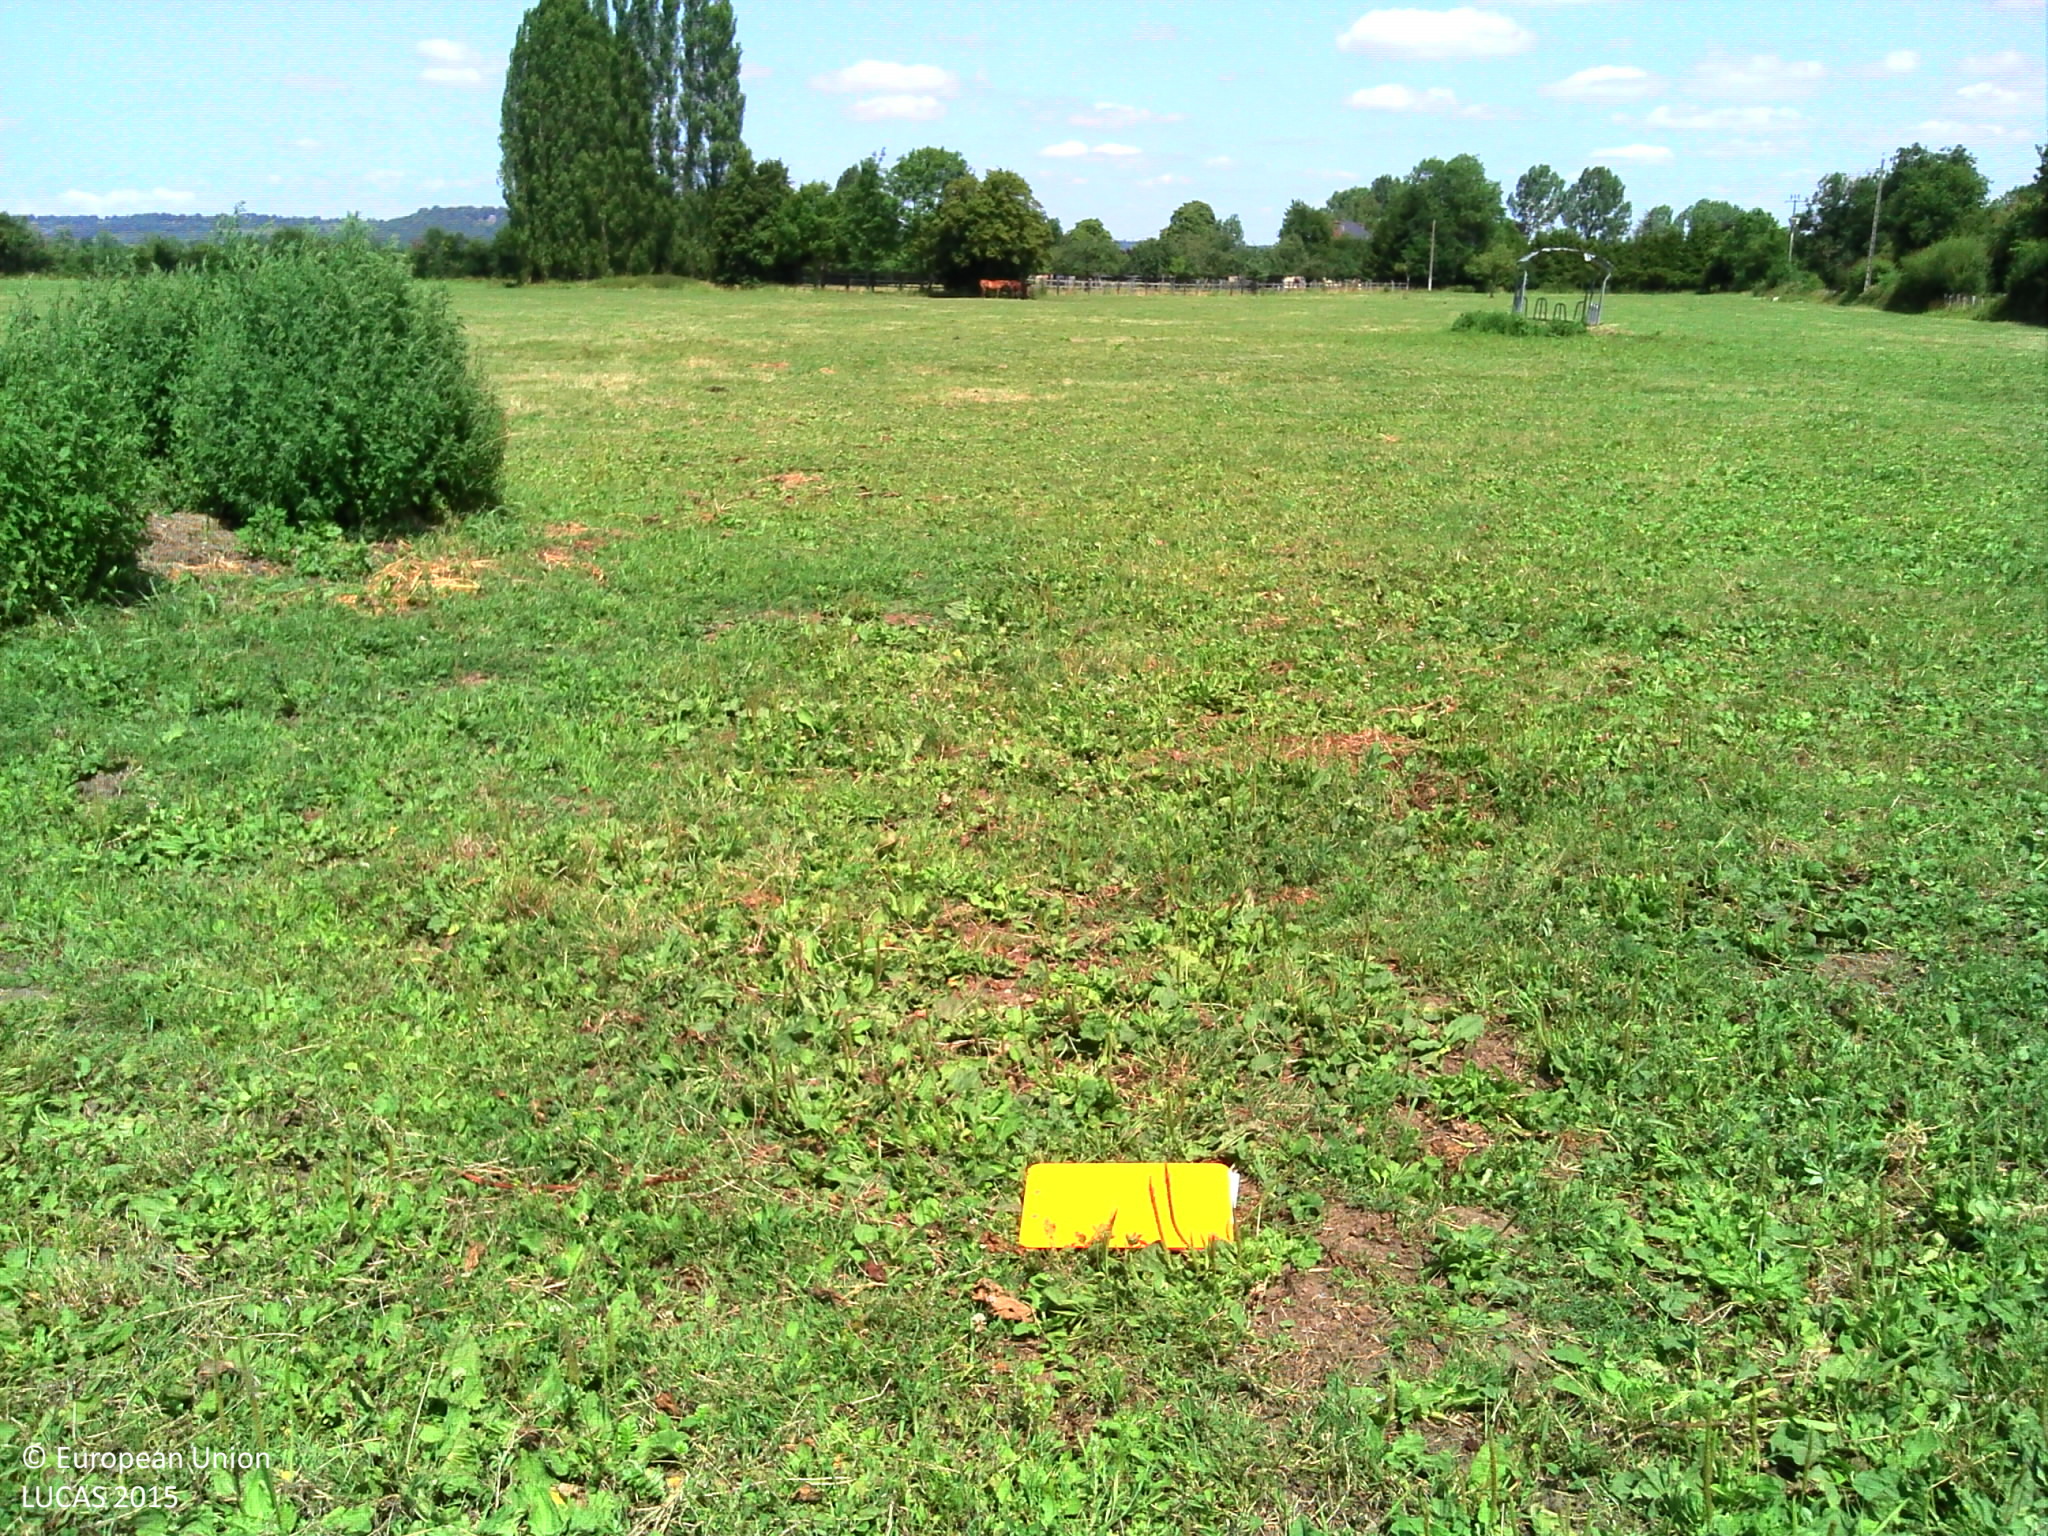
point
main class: Grassland
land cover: Grassland without tree/shrub cover
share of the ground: > 75 %
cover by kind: herbaceous plants 100 %
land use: Agriculture (excluding fallow land and kitchen gardens)
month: July
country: FR
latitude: 49.0898
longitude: -0.0136
